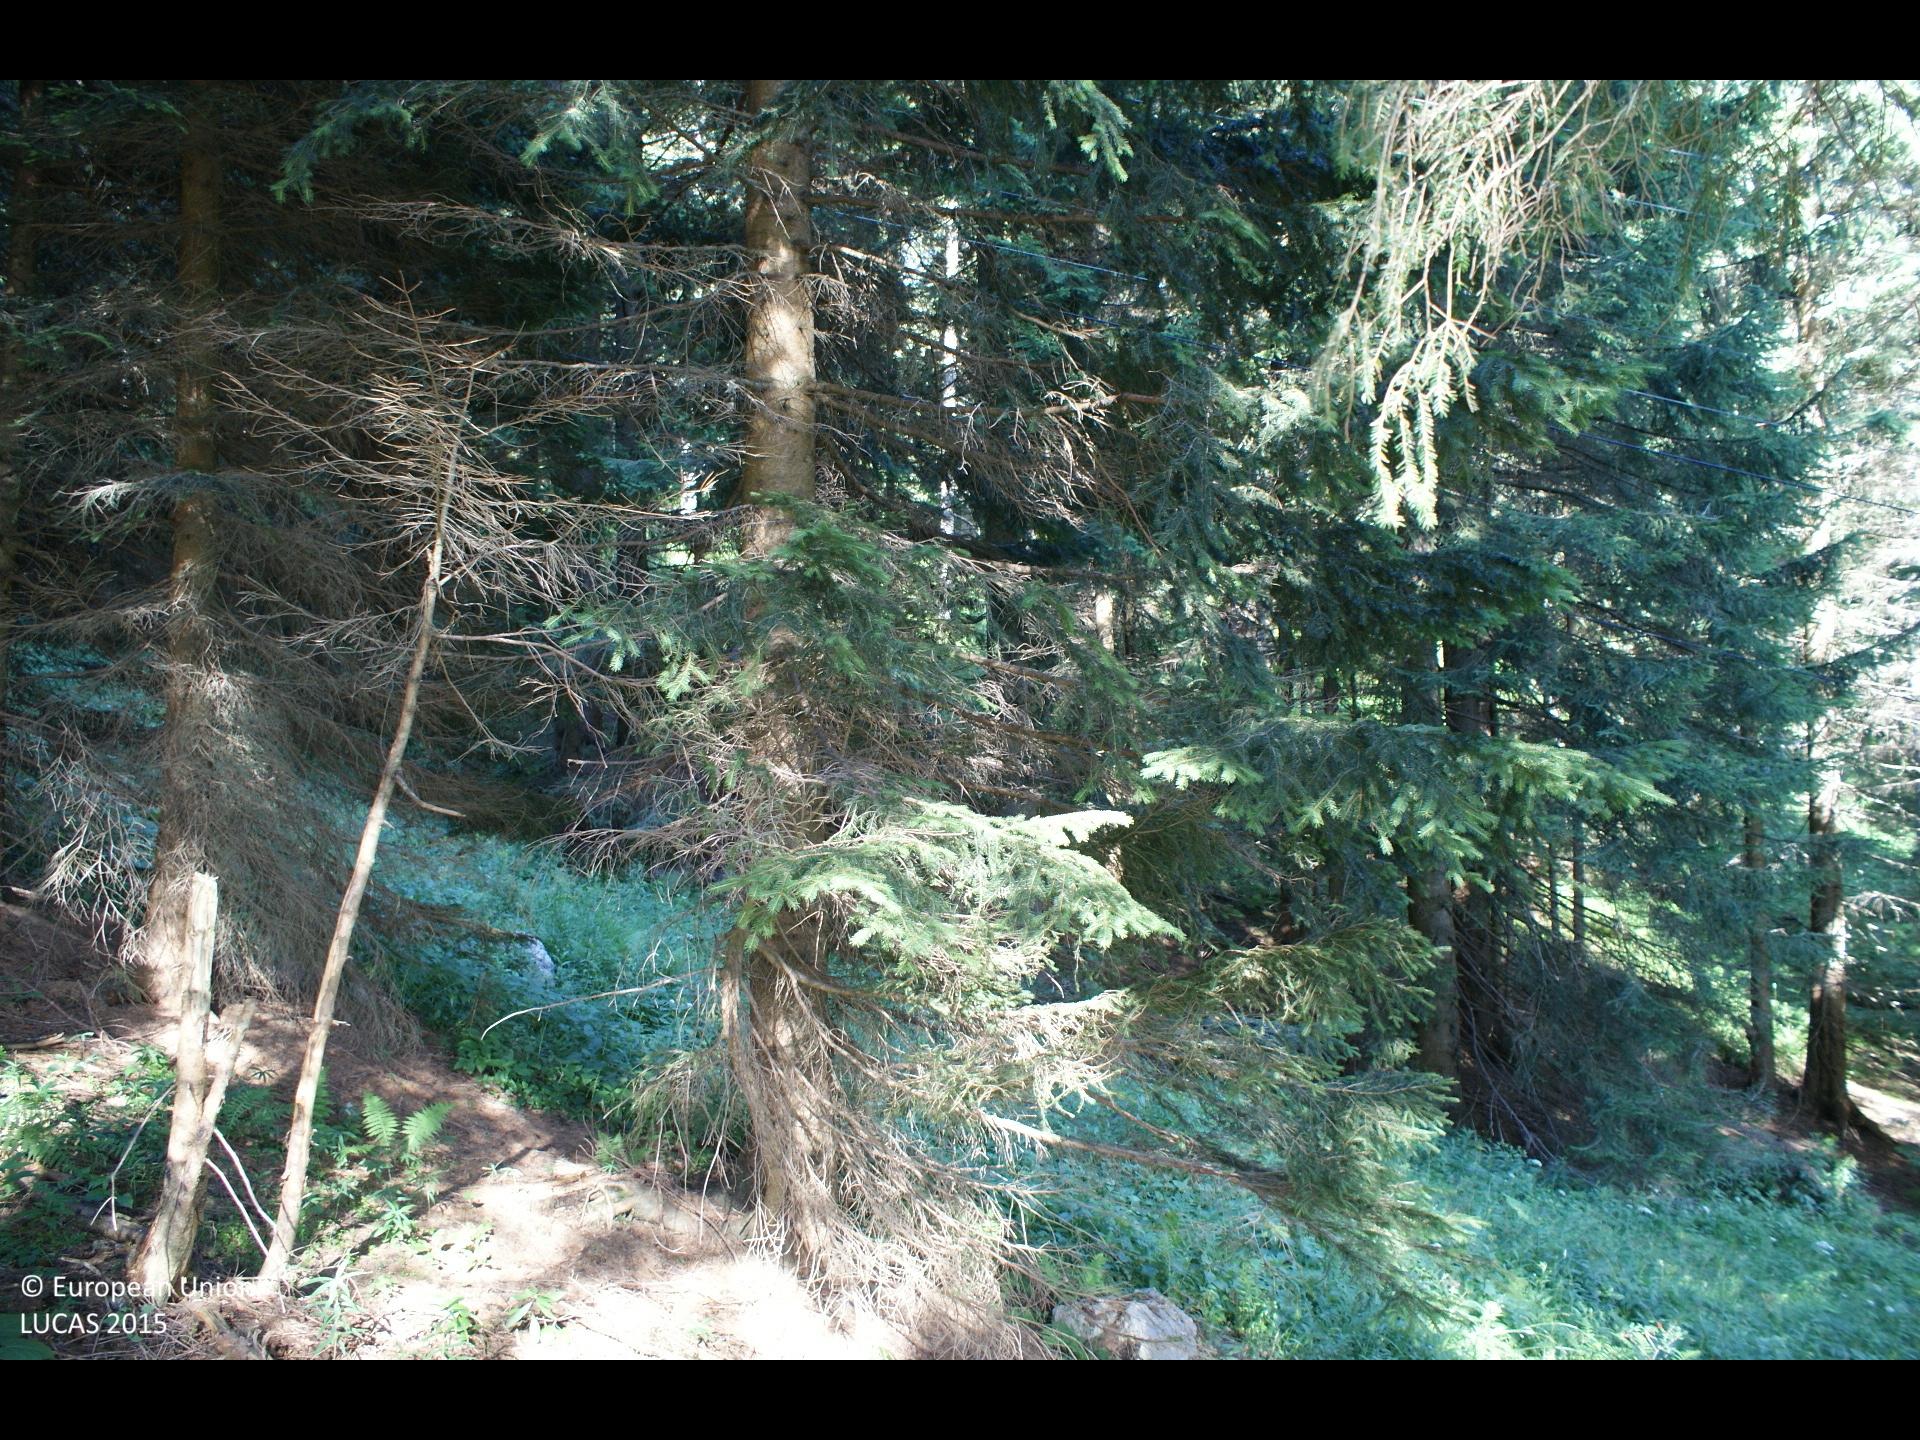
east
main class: Woodland
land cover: Spruce dominated coniferous woodland
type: alpine coniferous forest
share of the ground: > 75 %
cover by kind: coniferous forest trees 80 %, herbaceous plants 20 %
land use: Forestry
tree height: > 5 m
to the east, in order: Spruce dominated coniferous woodland; Electric lines; Spruce dominated coniferous woodland; Tracks; Spruce dominated coniferous woodland; Tracks; Spruce dominated coniferous woodland
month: July
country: AT
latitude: 47.8984
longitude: 15.2849
